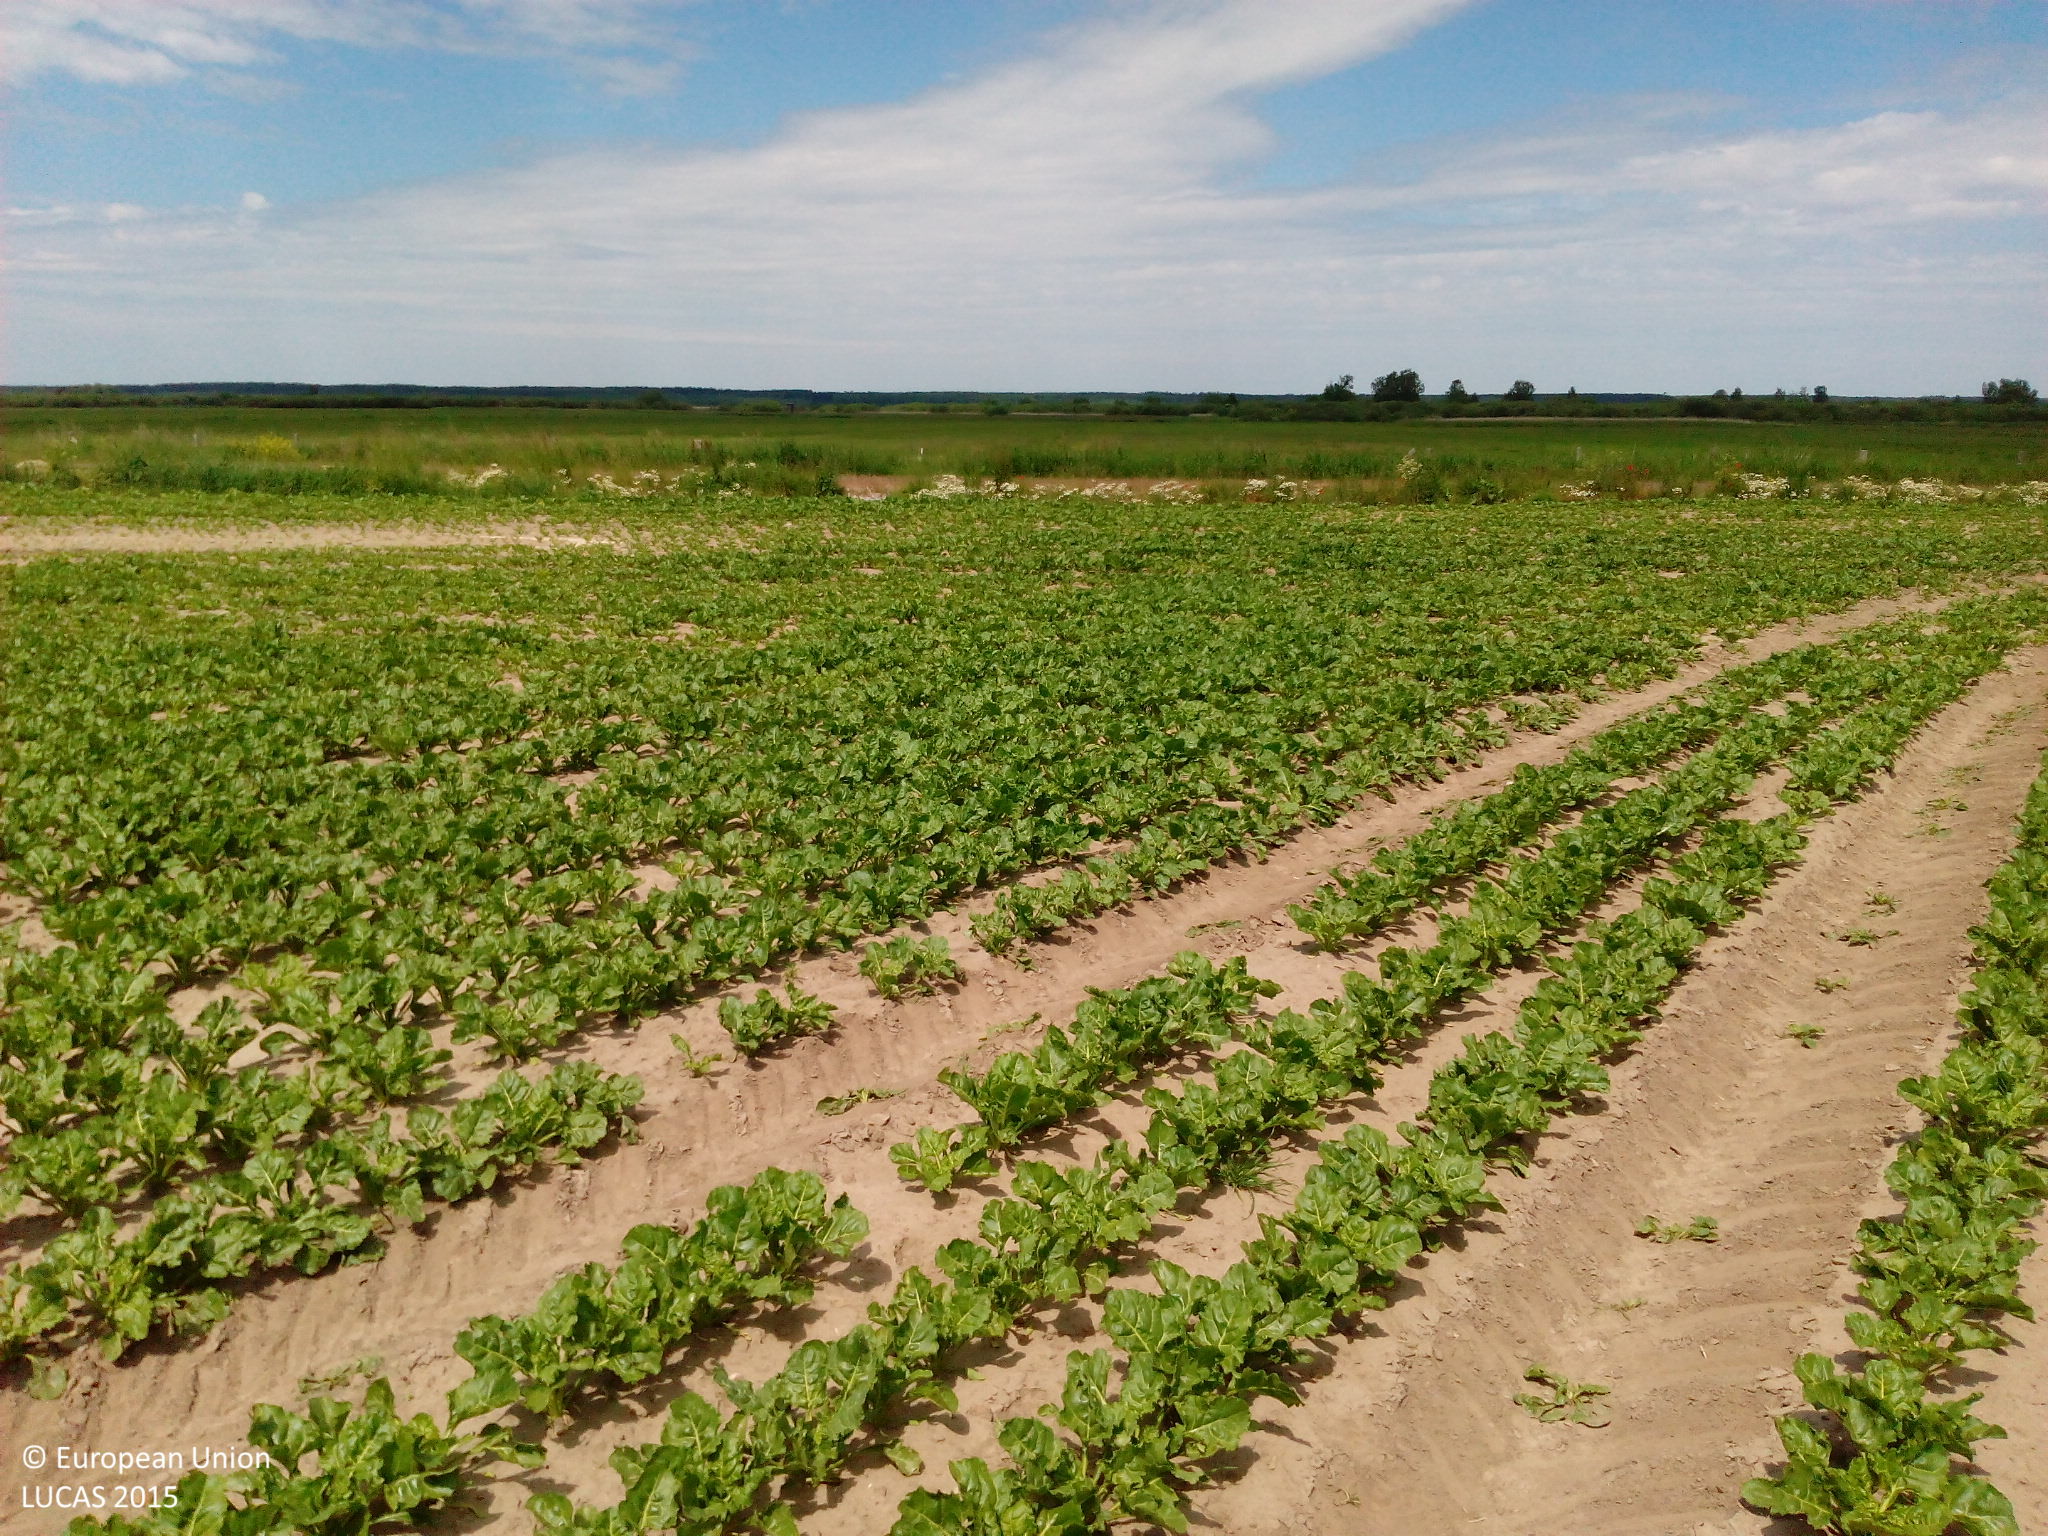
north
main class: Cropland
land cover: Sugar beet
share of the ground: 50 - 75 %
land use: Agriculture (excluding fallow land and kitchen gardens)
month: June
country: DE
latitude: 53.8476
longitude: 13.7543
